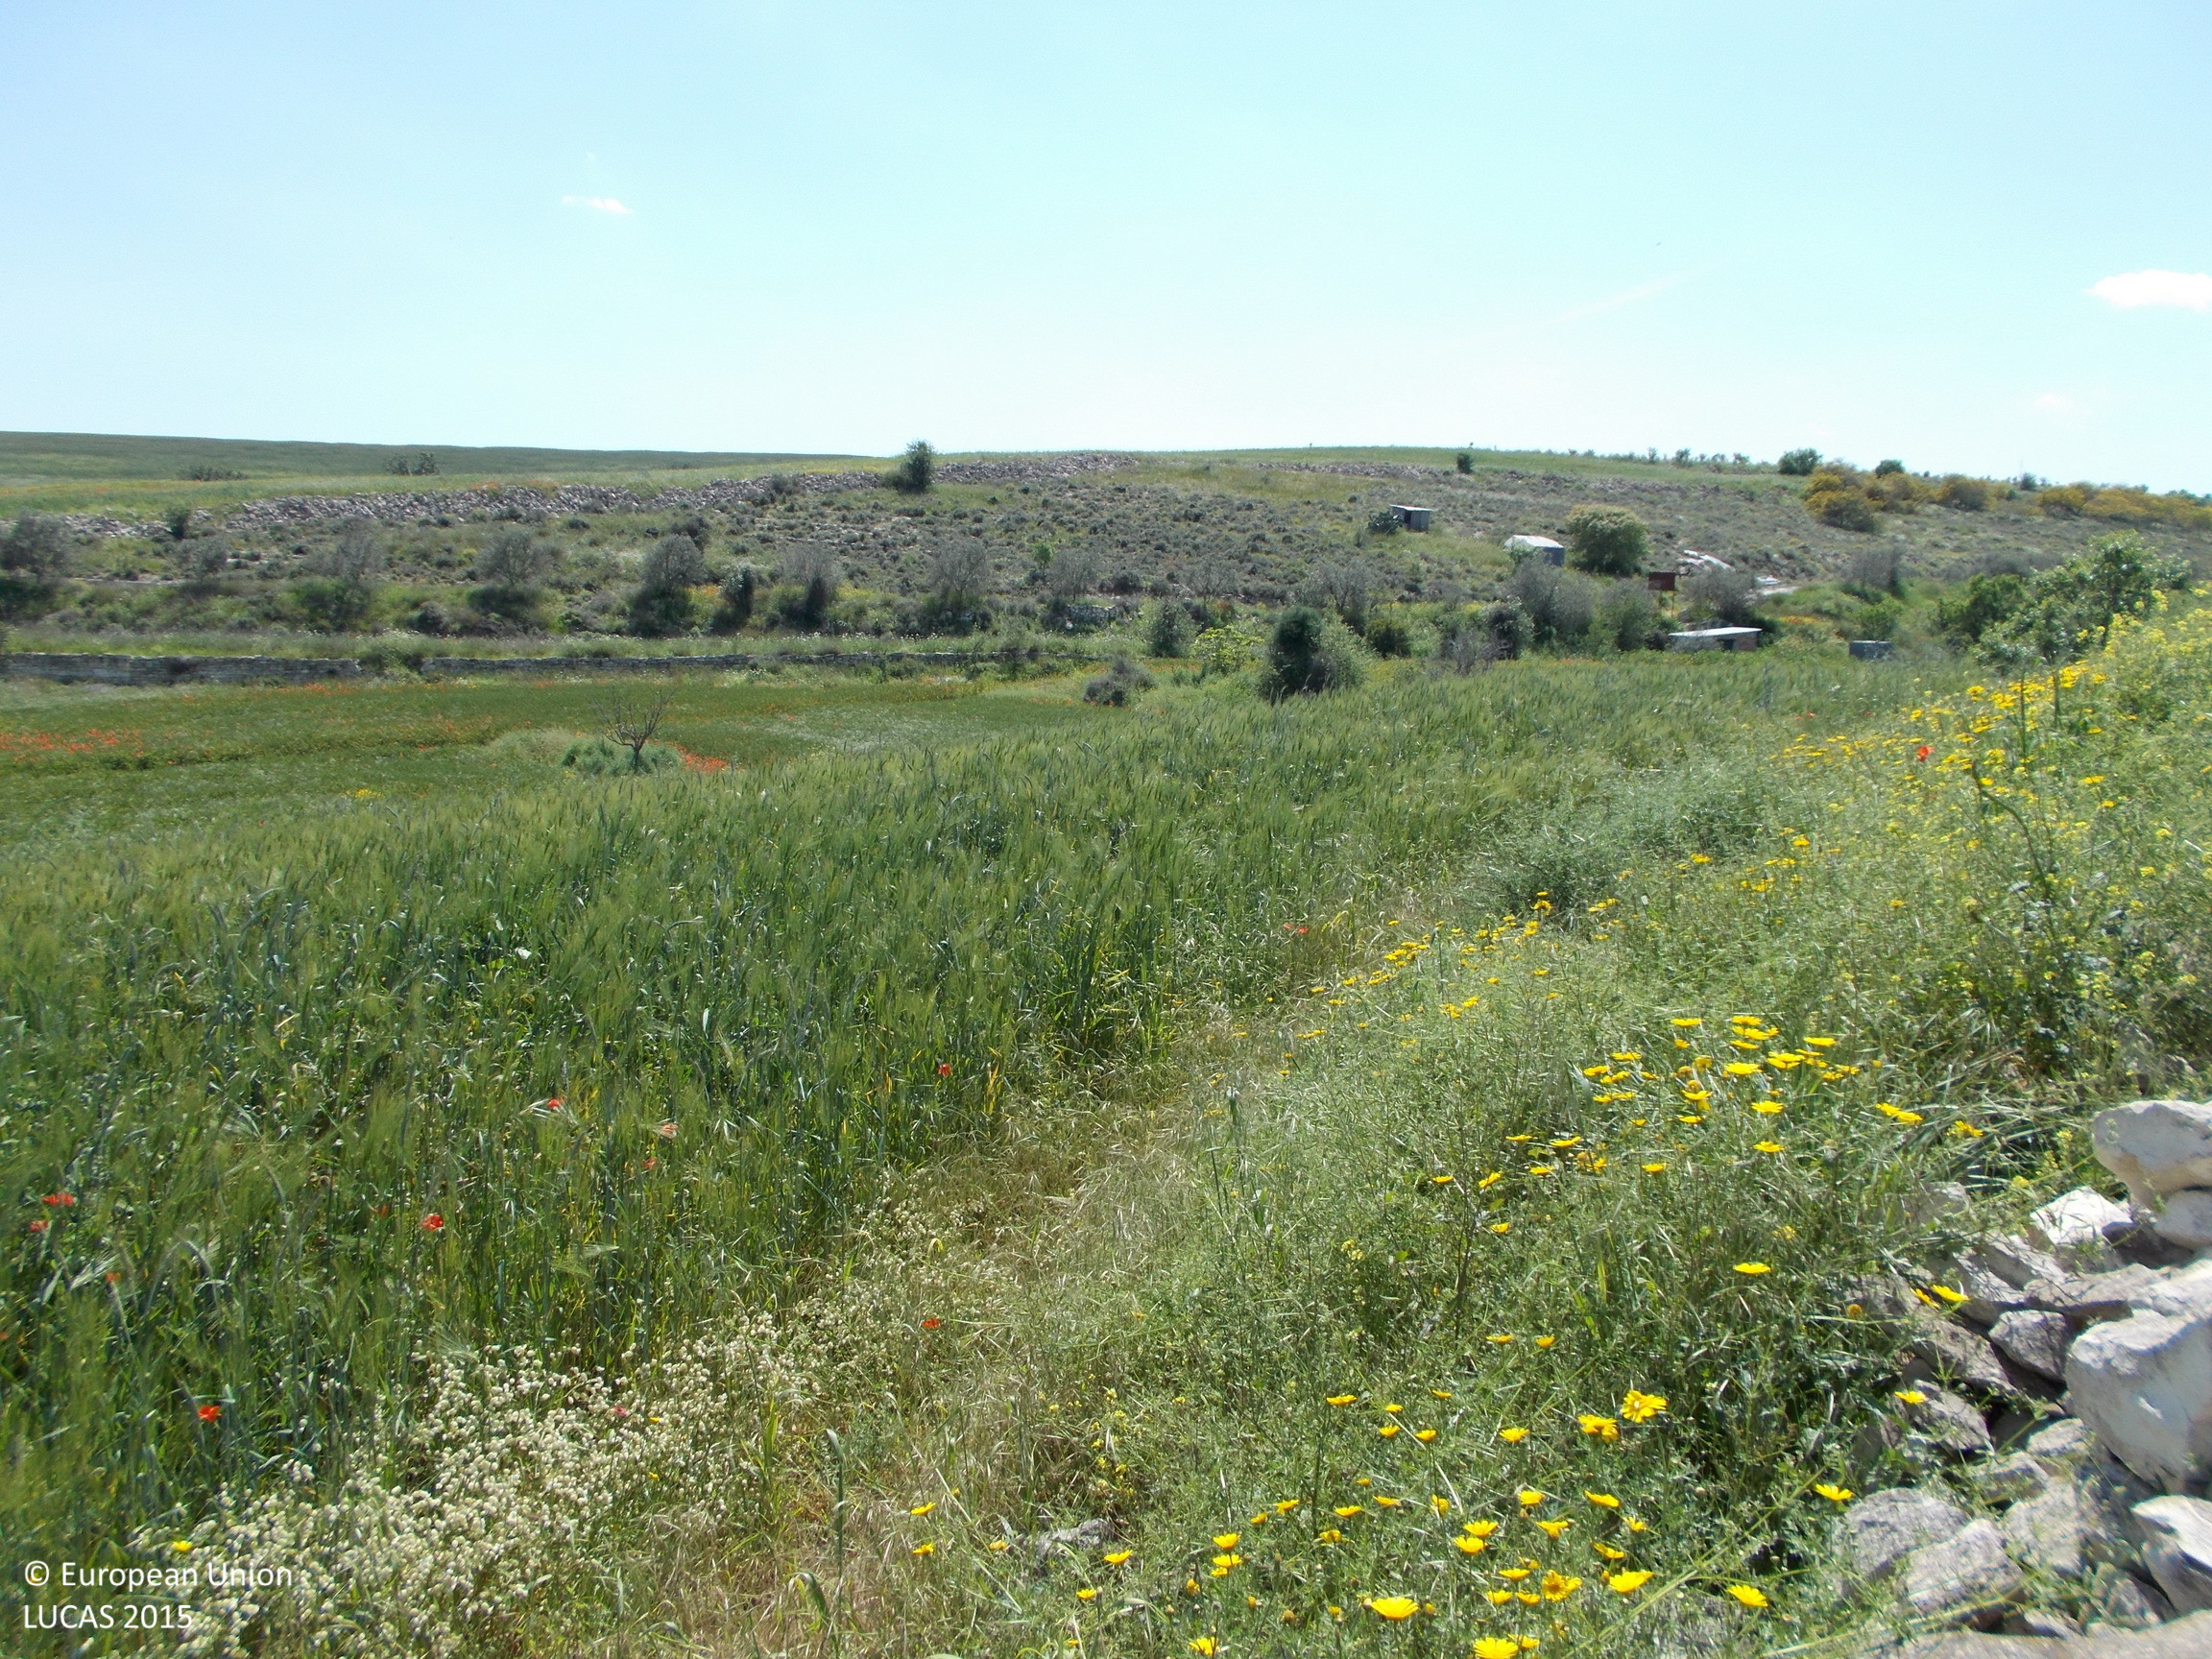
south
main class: Grassland
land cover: Grassland without tree/shrub cover
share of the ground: 25 - 50 %
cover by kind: herbaceous plants 50 %, consolidated bare surface 50 %
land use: Semi-natural and natural areas not in use
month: April
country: CY
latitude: 35.0262
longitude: 33.5533
